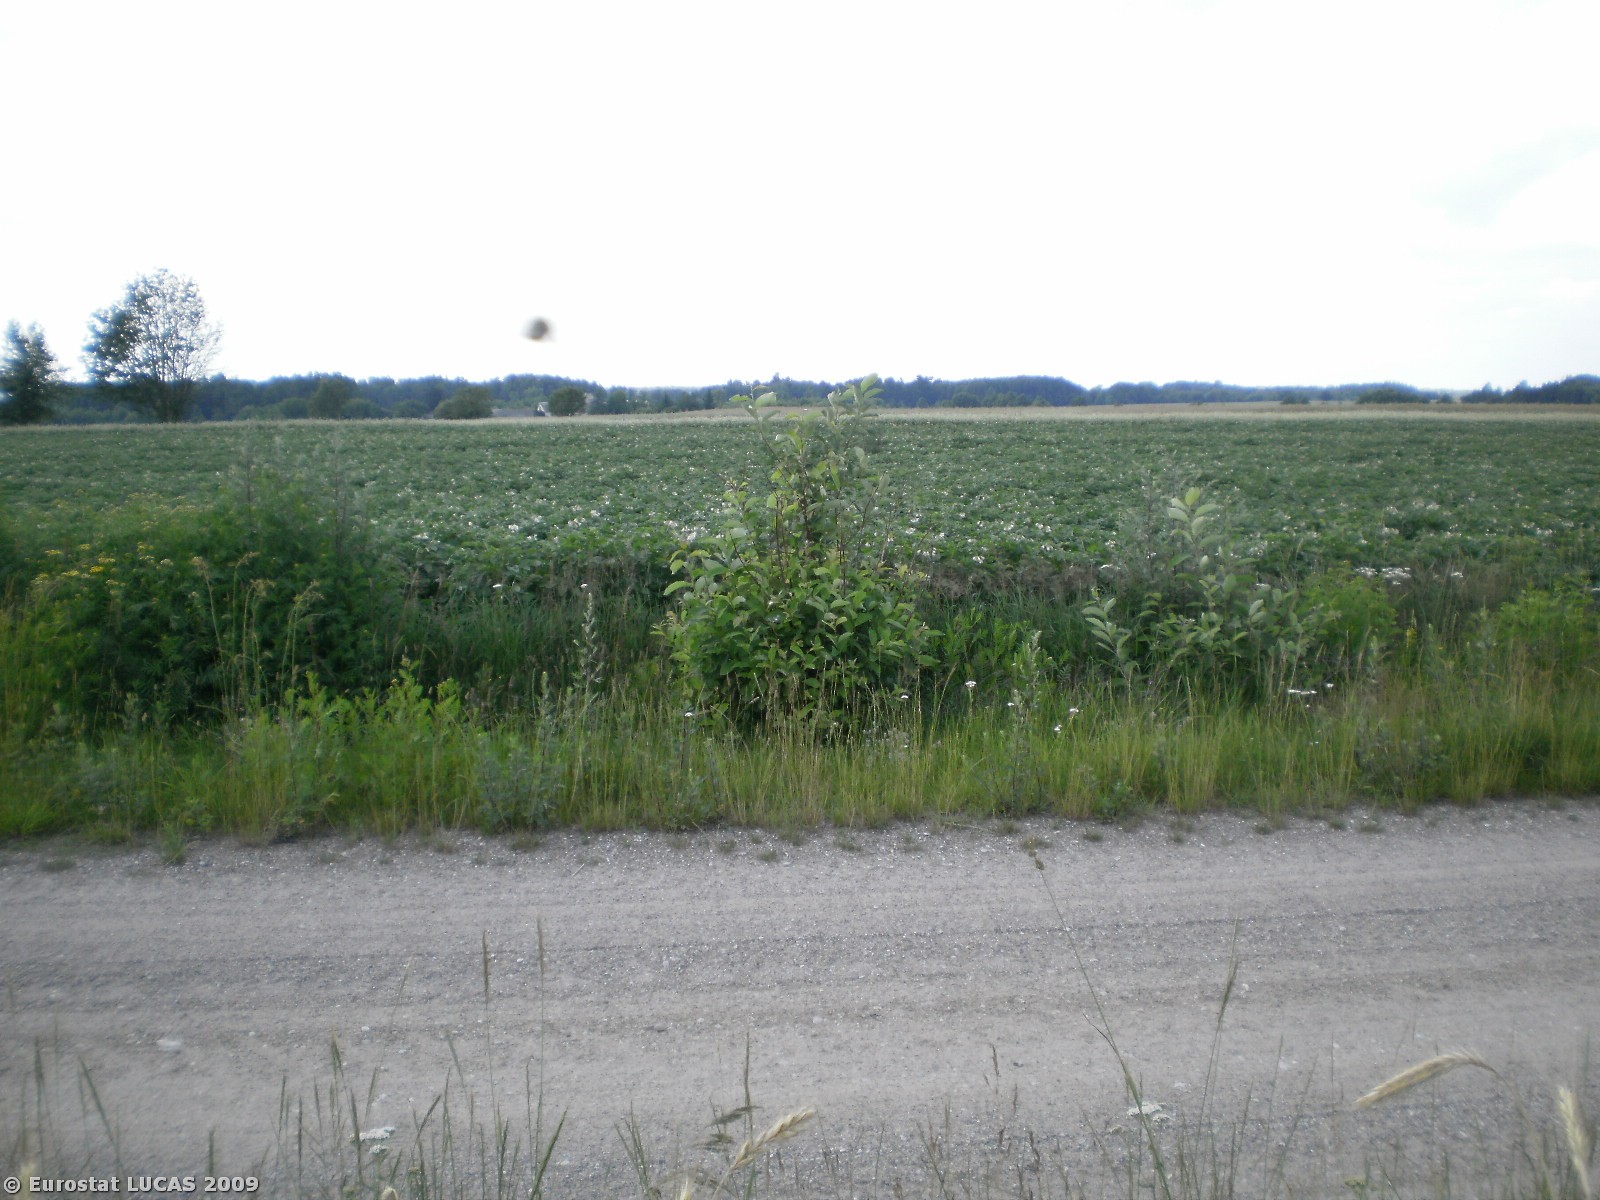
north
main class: Cropland
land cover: Triticale
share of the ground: > 75 %
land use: Agriculture (excluding fallow land and kitchen gardens)
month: July
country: PL
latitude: 53.2538
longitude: 20.4844
